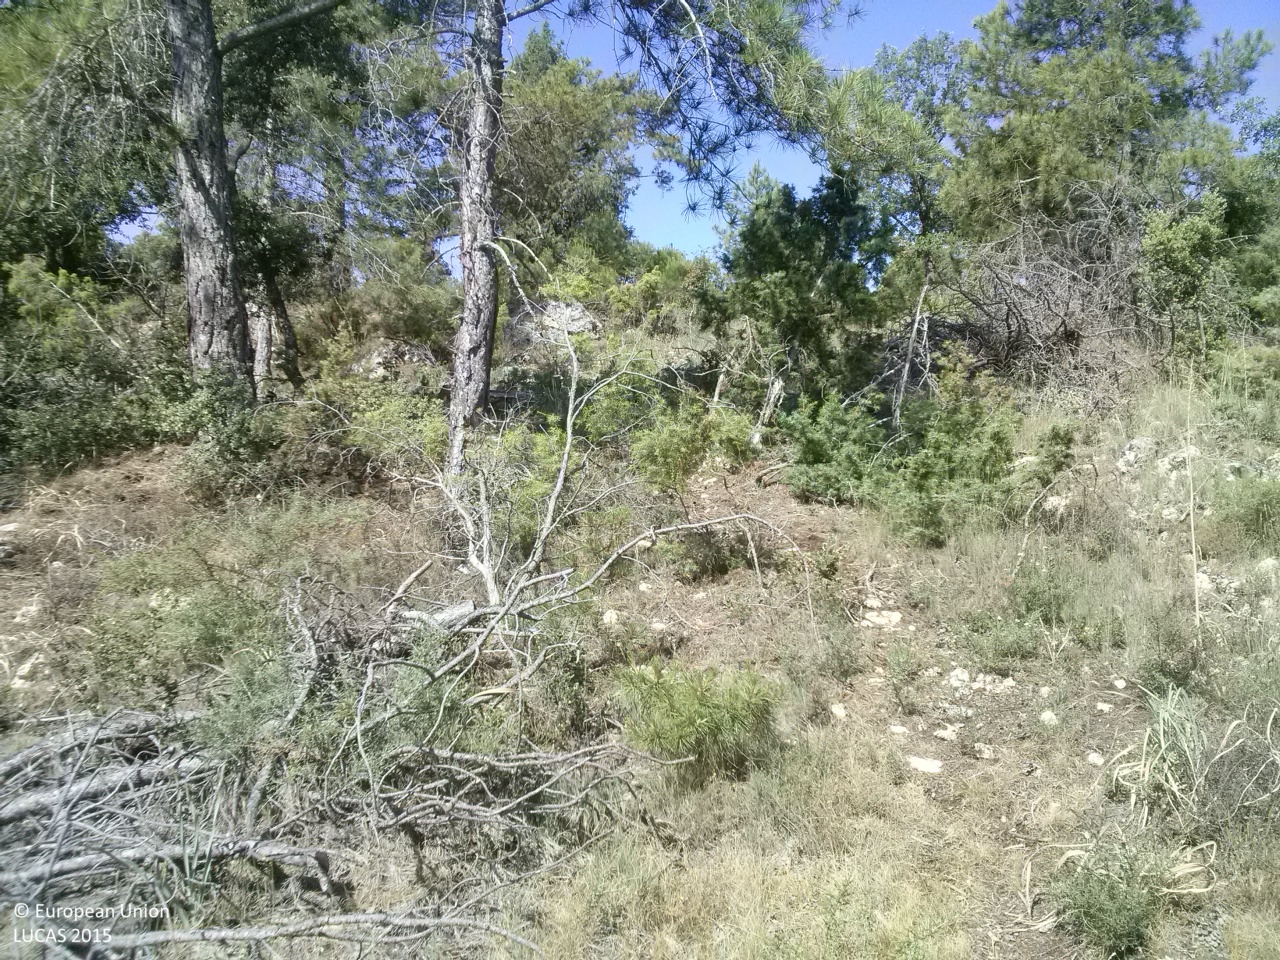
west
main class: Woodland
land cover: Pine dominated mixed woodland
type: coniferous forest of the mediterranean region
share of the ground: 10 - 25 %
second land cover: Shrubland without tree cover
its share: 25 - 50 %
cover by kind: shrubs 40 %, herbaceous plants 30 %, coniferous forest trees 20 %, broadleaved forest trees 10 %
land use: Forestry
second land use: Agriculture (excluding fallow land and kitchen gardens)
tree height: > 5 m
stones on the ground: 25 - 50 %
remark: Clear cut
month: June
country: ES
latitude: 39.9768
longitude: -1.6143
